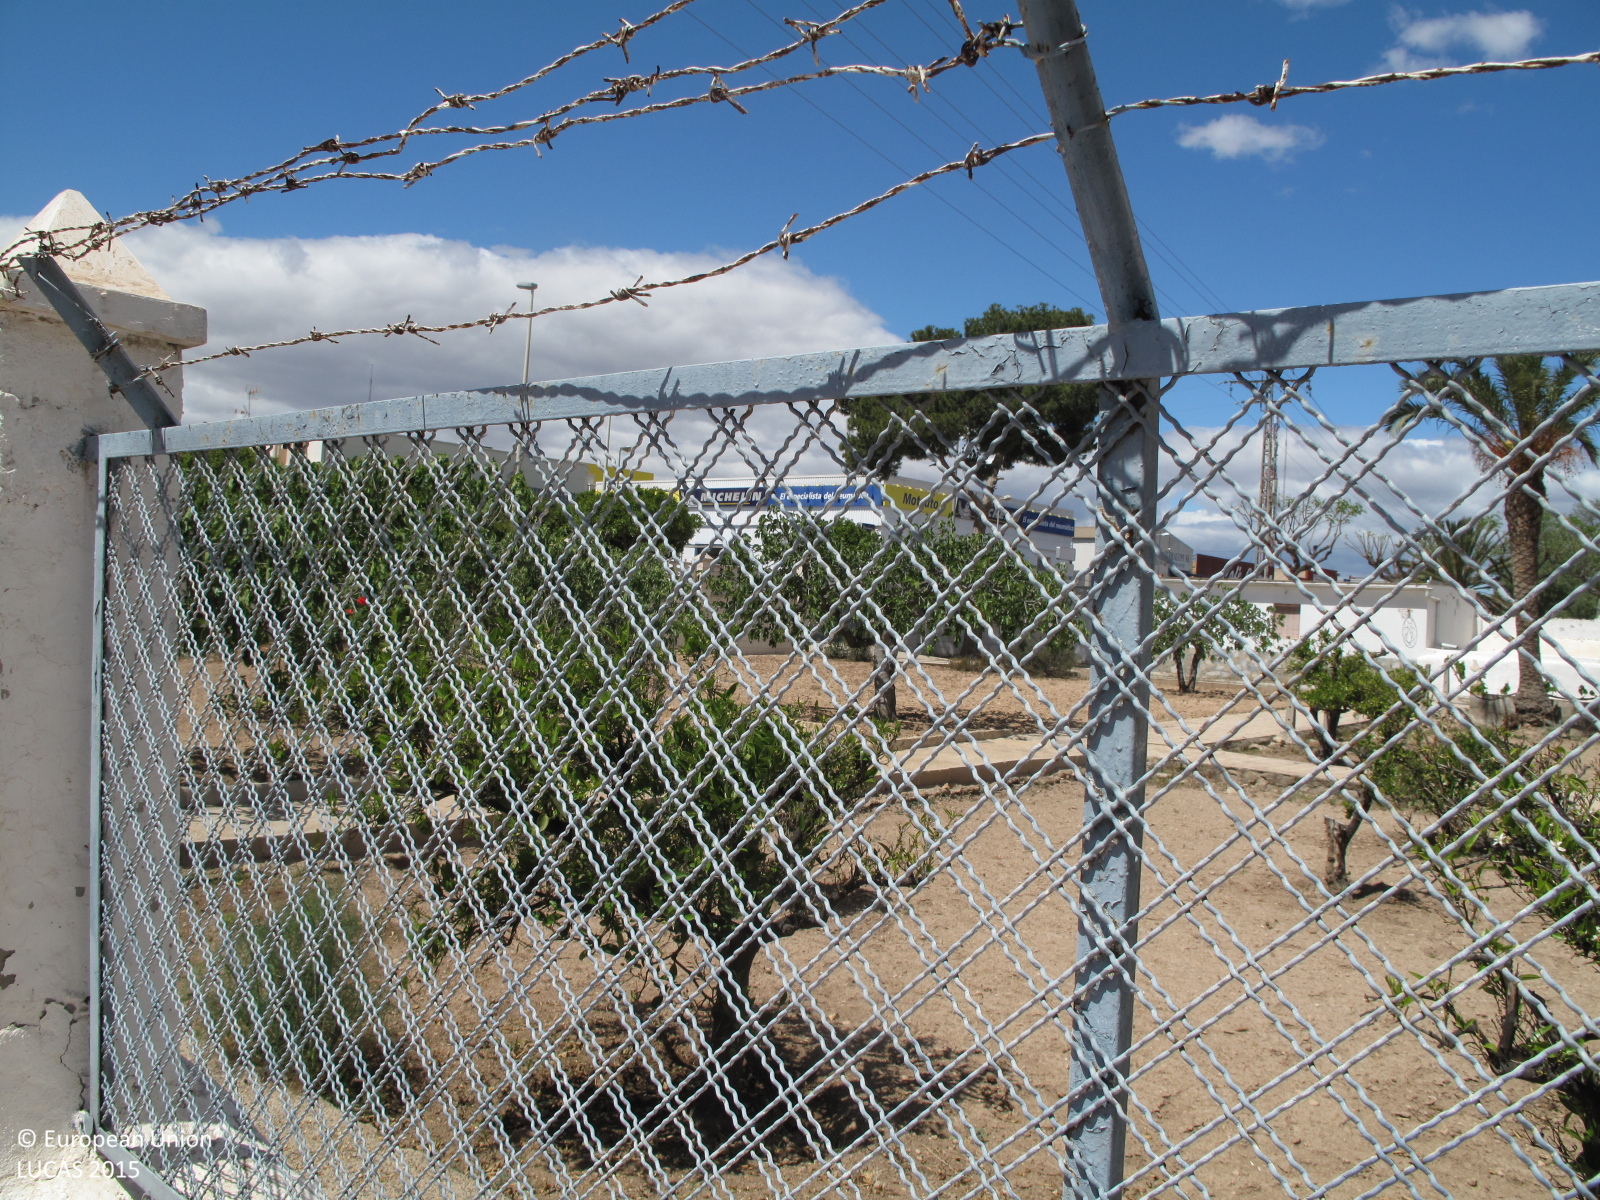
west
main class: Cropland
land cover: Oranges
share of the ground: < 10 %
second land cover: Other bare soil
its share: > 75 %
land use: Kitchen garden
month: April
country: ES
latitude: 38.3878
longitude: -0.5073
